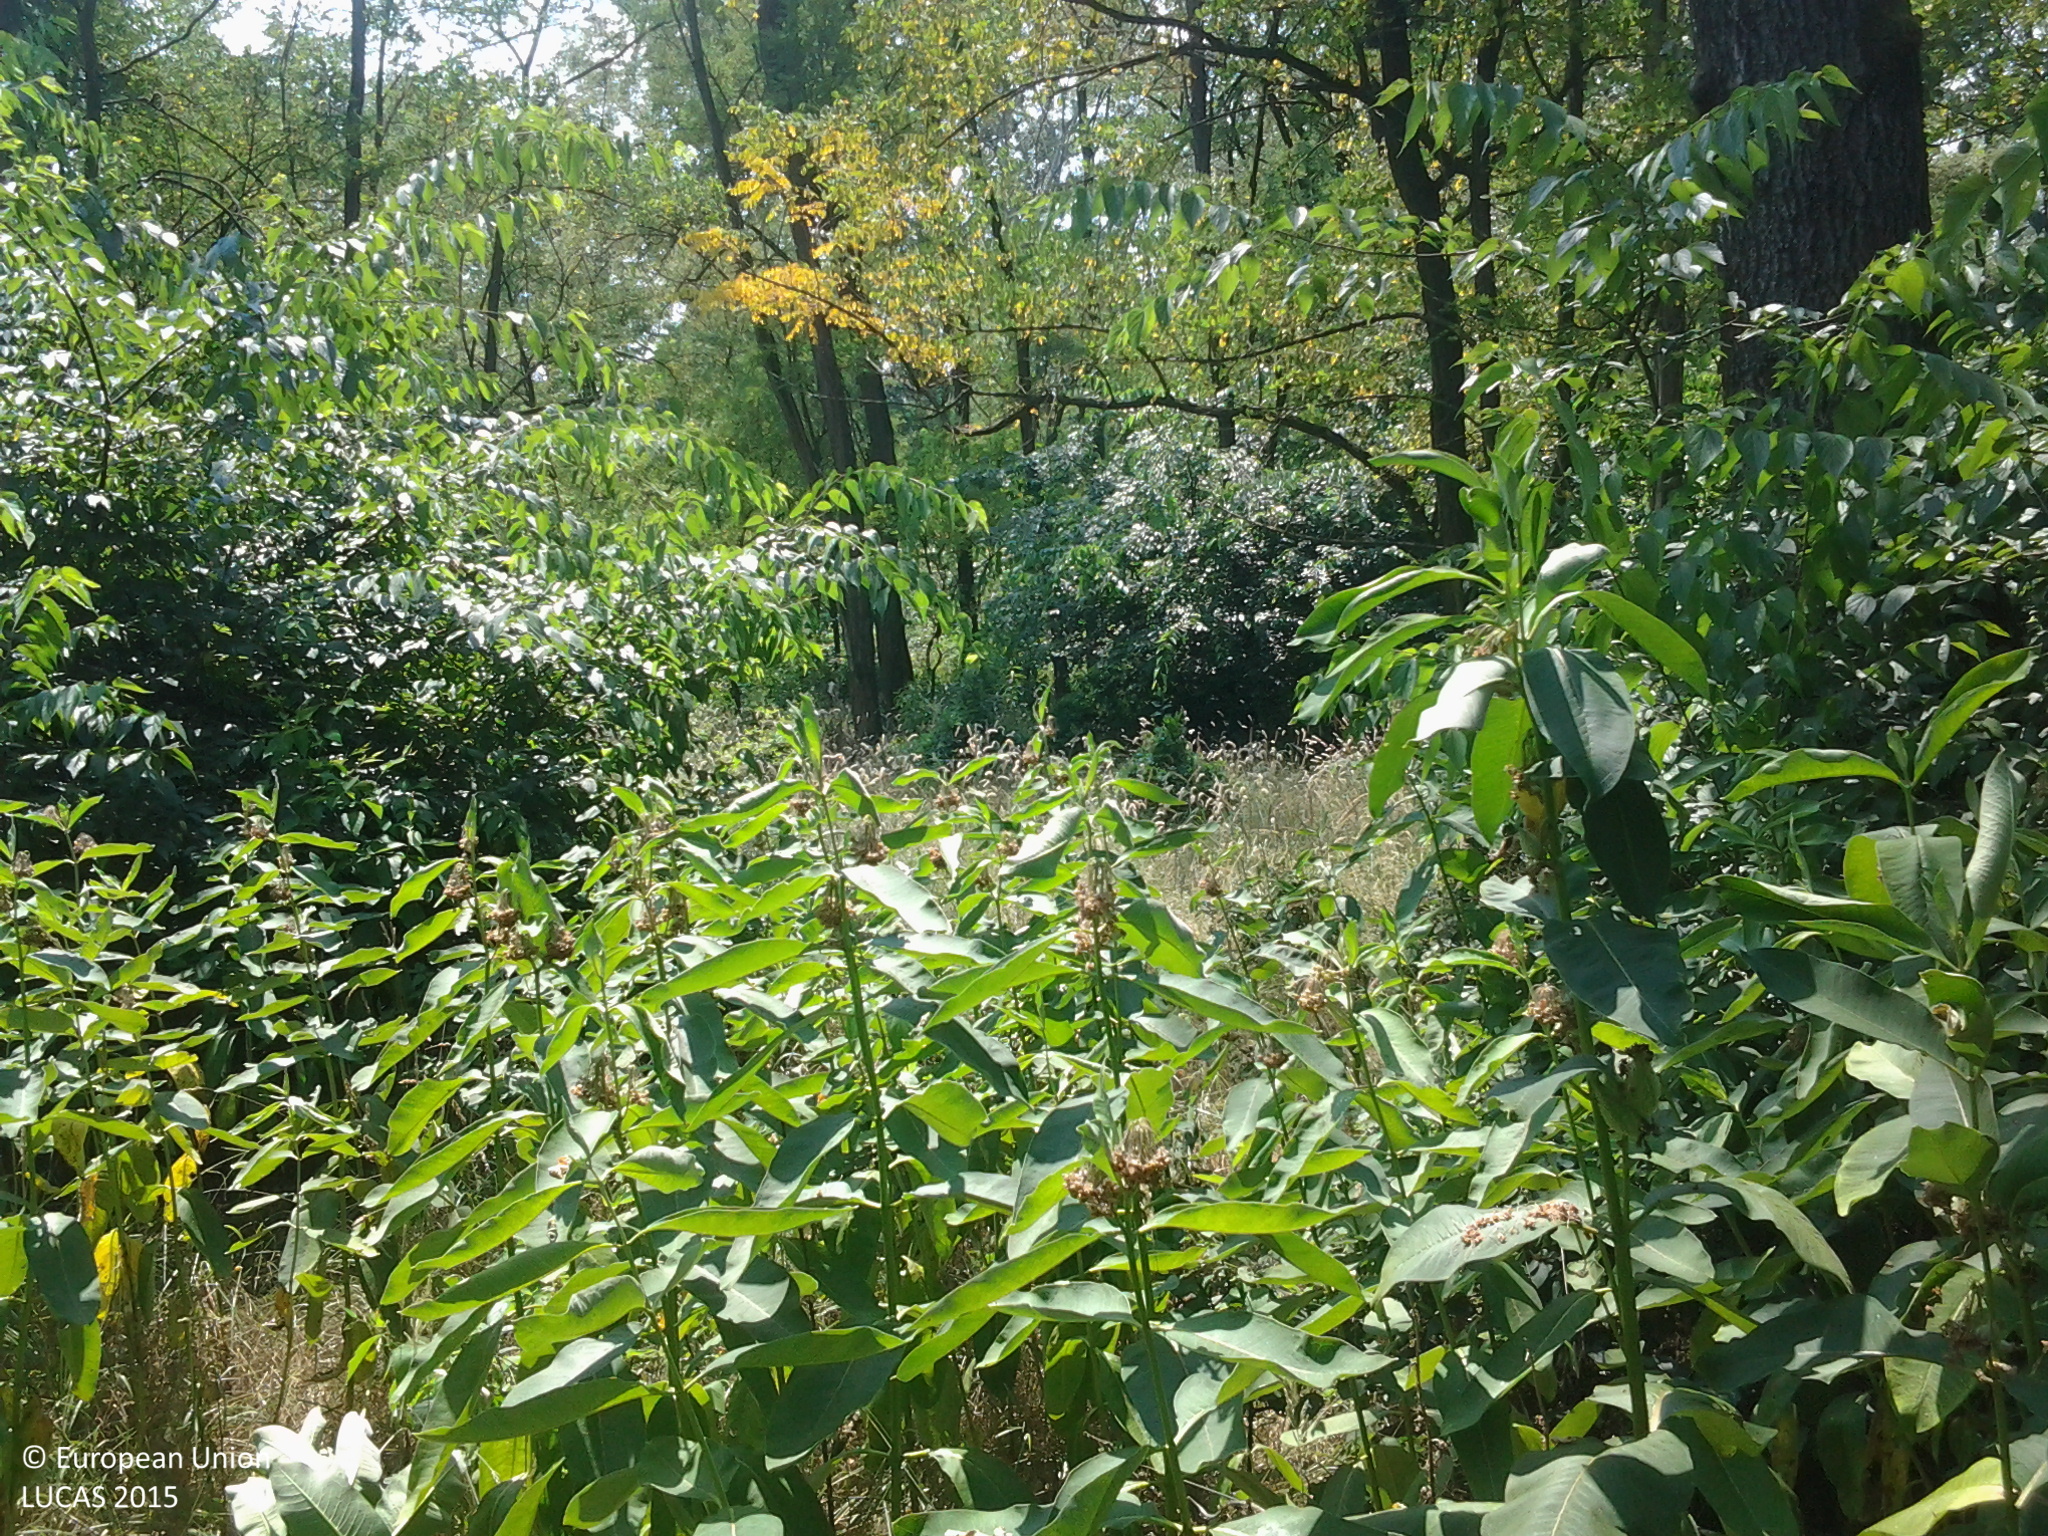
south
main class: Woodland
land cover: Pine dominated coniferous woodland
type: hemiboreal forest and nemoral coniferous forest and mixed broadleaved-coniferous forest
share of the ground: 50 - 75 %
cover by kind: coniferous forest trees 65 %, herbaceous plants 15 %, broadleaved forest trees 10 %, shrubs 10 %
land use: Forestry
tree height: > 5 m
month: July
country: HU
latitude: 46.6550
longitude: 19.6763
